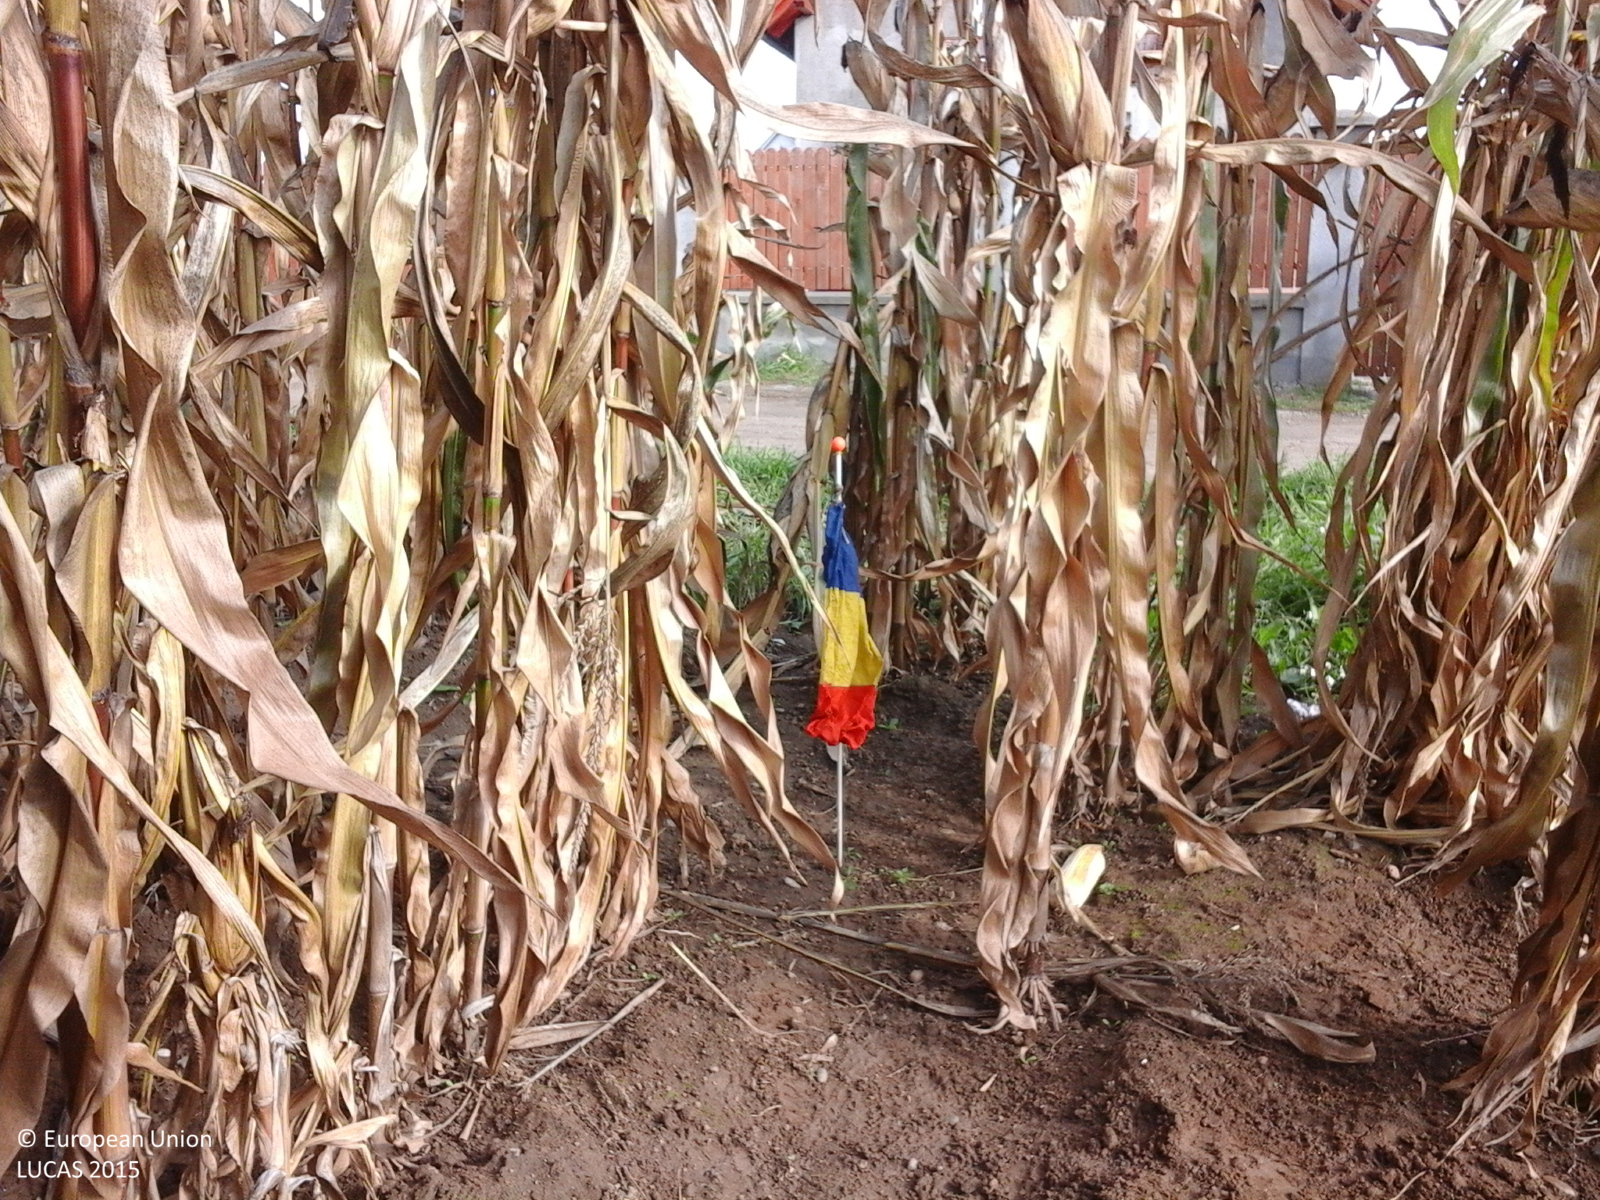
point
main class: Cropland
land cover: Maize
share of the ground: > 75 %
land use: Agriculture (excluding fallow land and kitchen gardens)
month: October
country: RO
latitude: 46.3214
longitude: 25.3118
